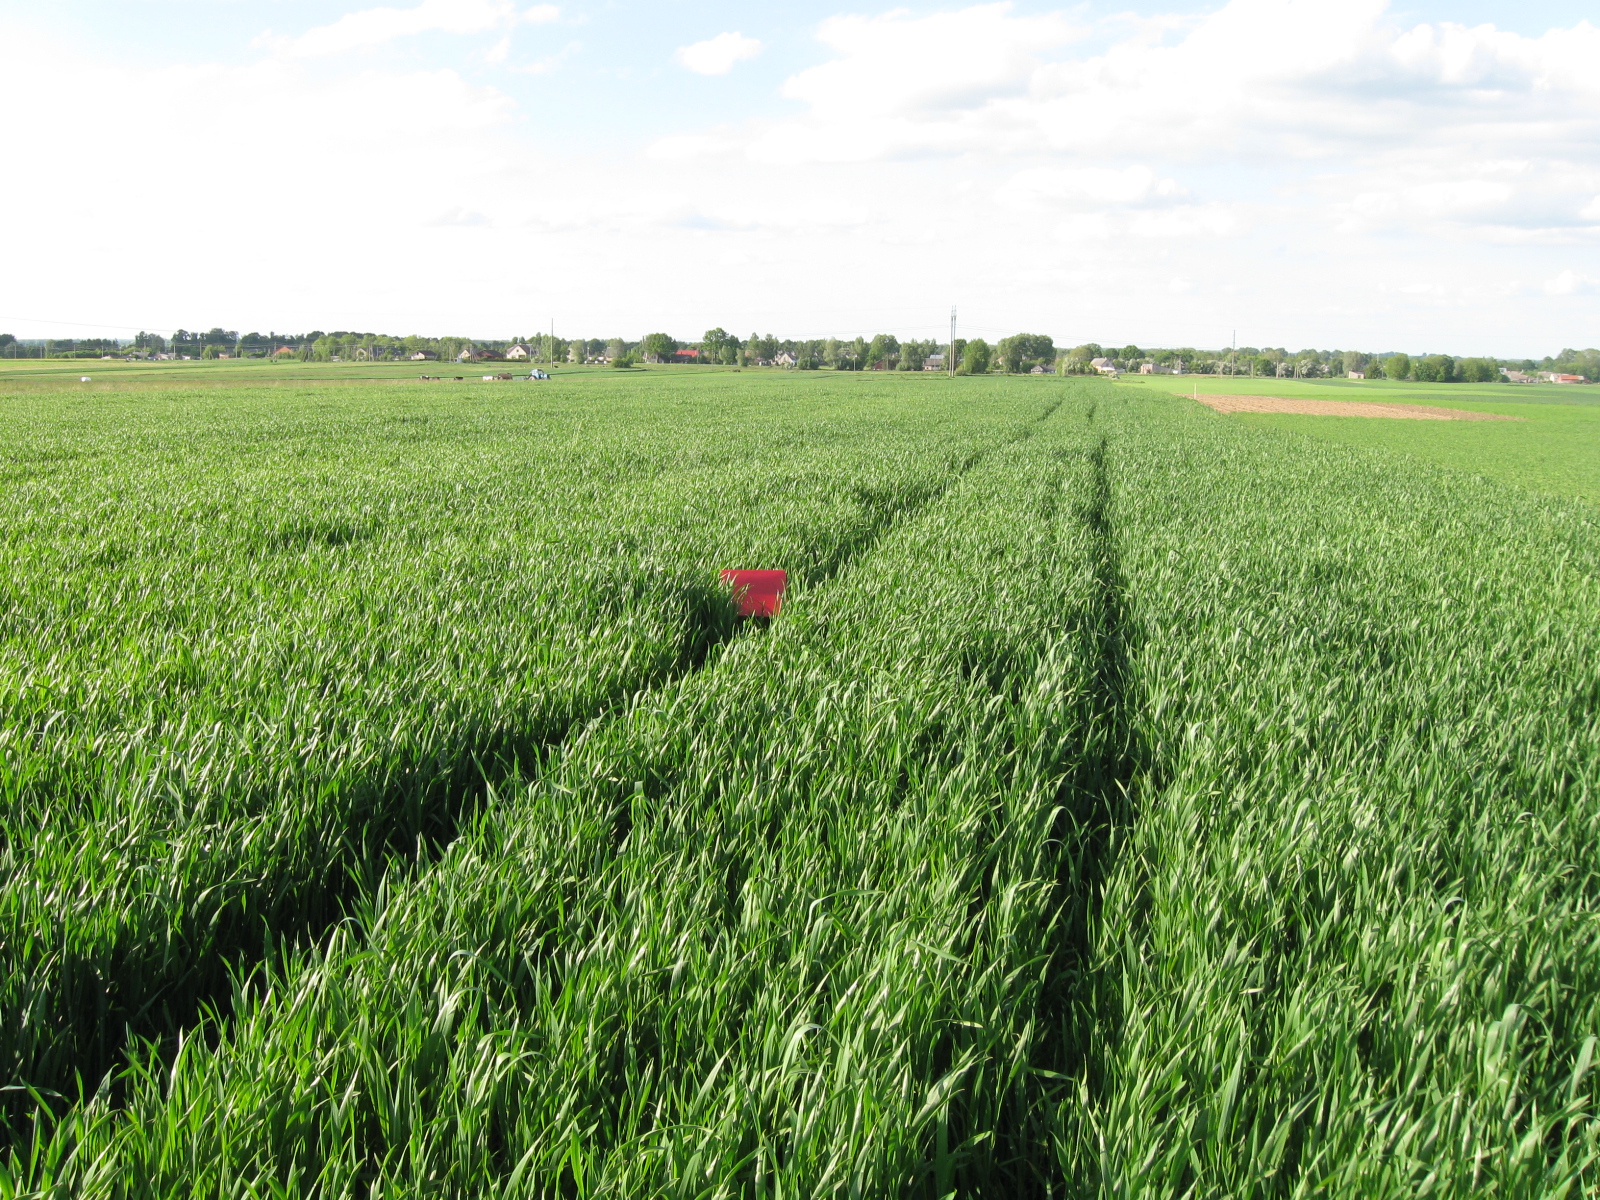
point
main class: Cropland
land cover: Common wheat
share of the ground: > 75 %
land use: Agriculture (excluding fallow land and kitchen gardens)
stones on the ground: < 10 %
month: May
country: LT
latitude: 54.6125
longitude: 22.8122
